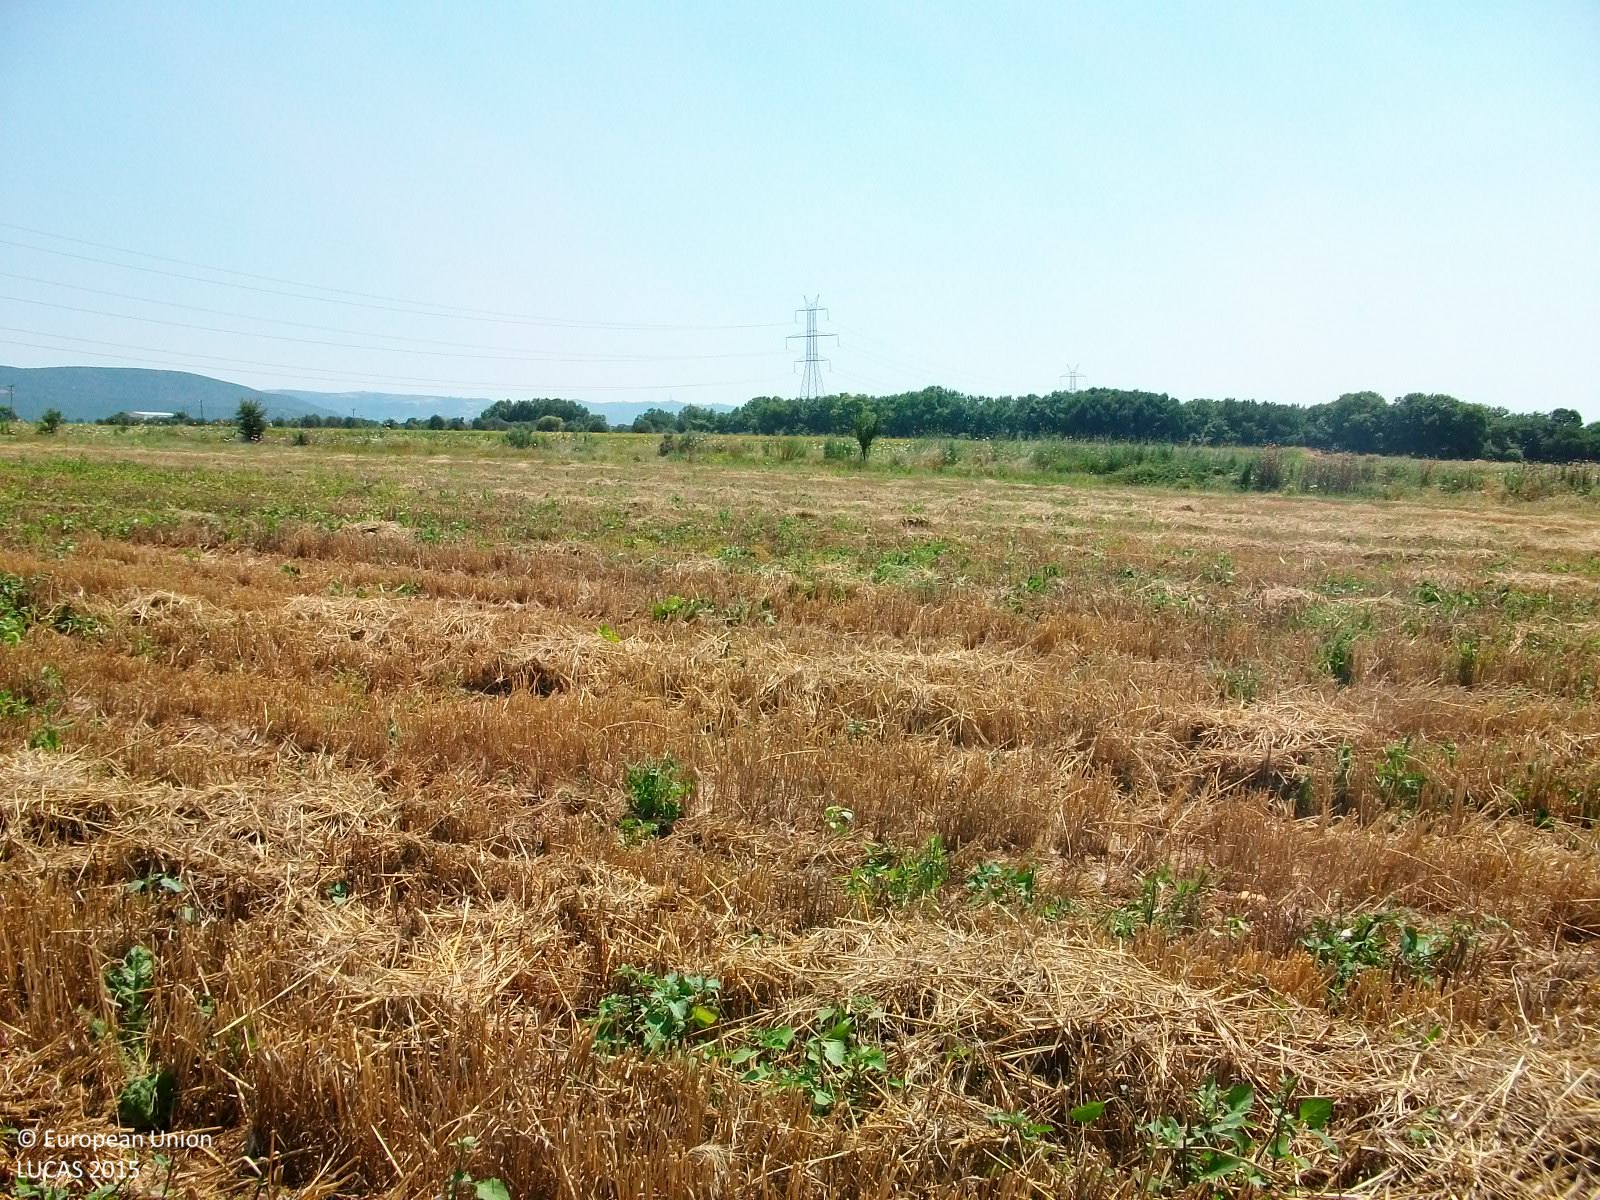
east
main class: Cropland
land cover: Durum wheat
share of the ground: > 75 %
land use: Agriculture (excluding fallow land and kitchen gardens)
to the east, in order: Durum wheat; Shruby margins; Cotton; Other leguminous and mixtures for fodder
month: July
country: GR
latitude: 38.6902
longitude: 22.5449
